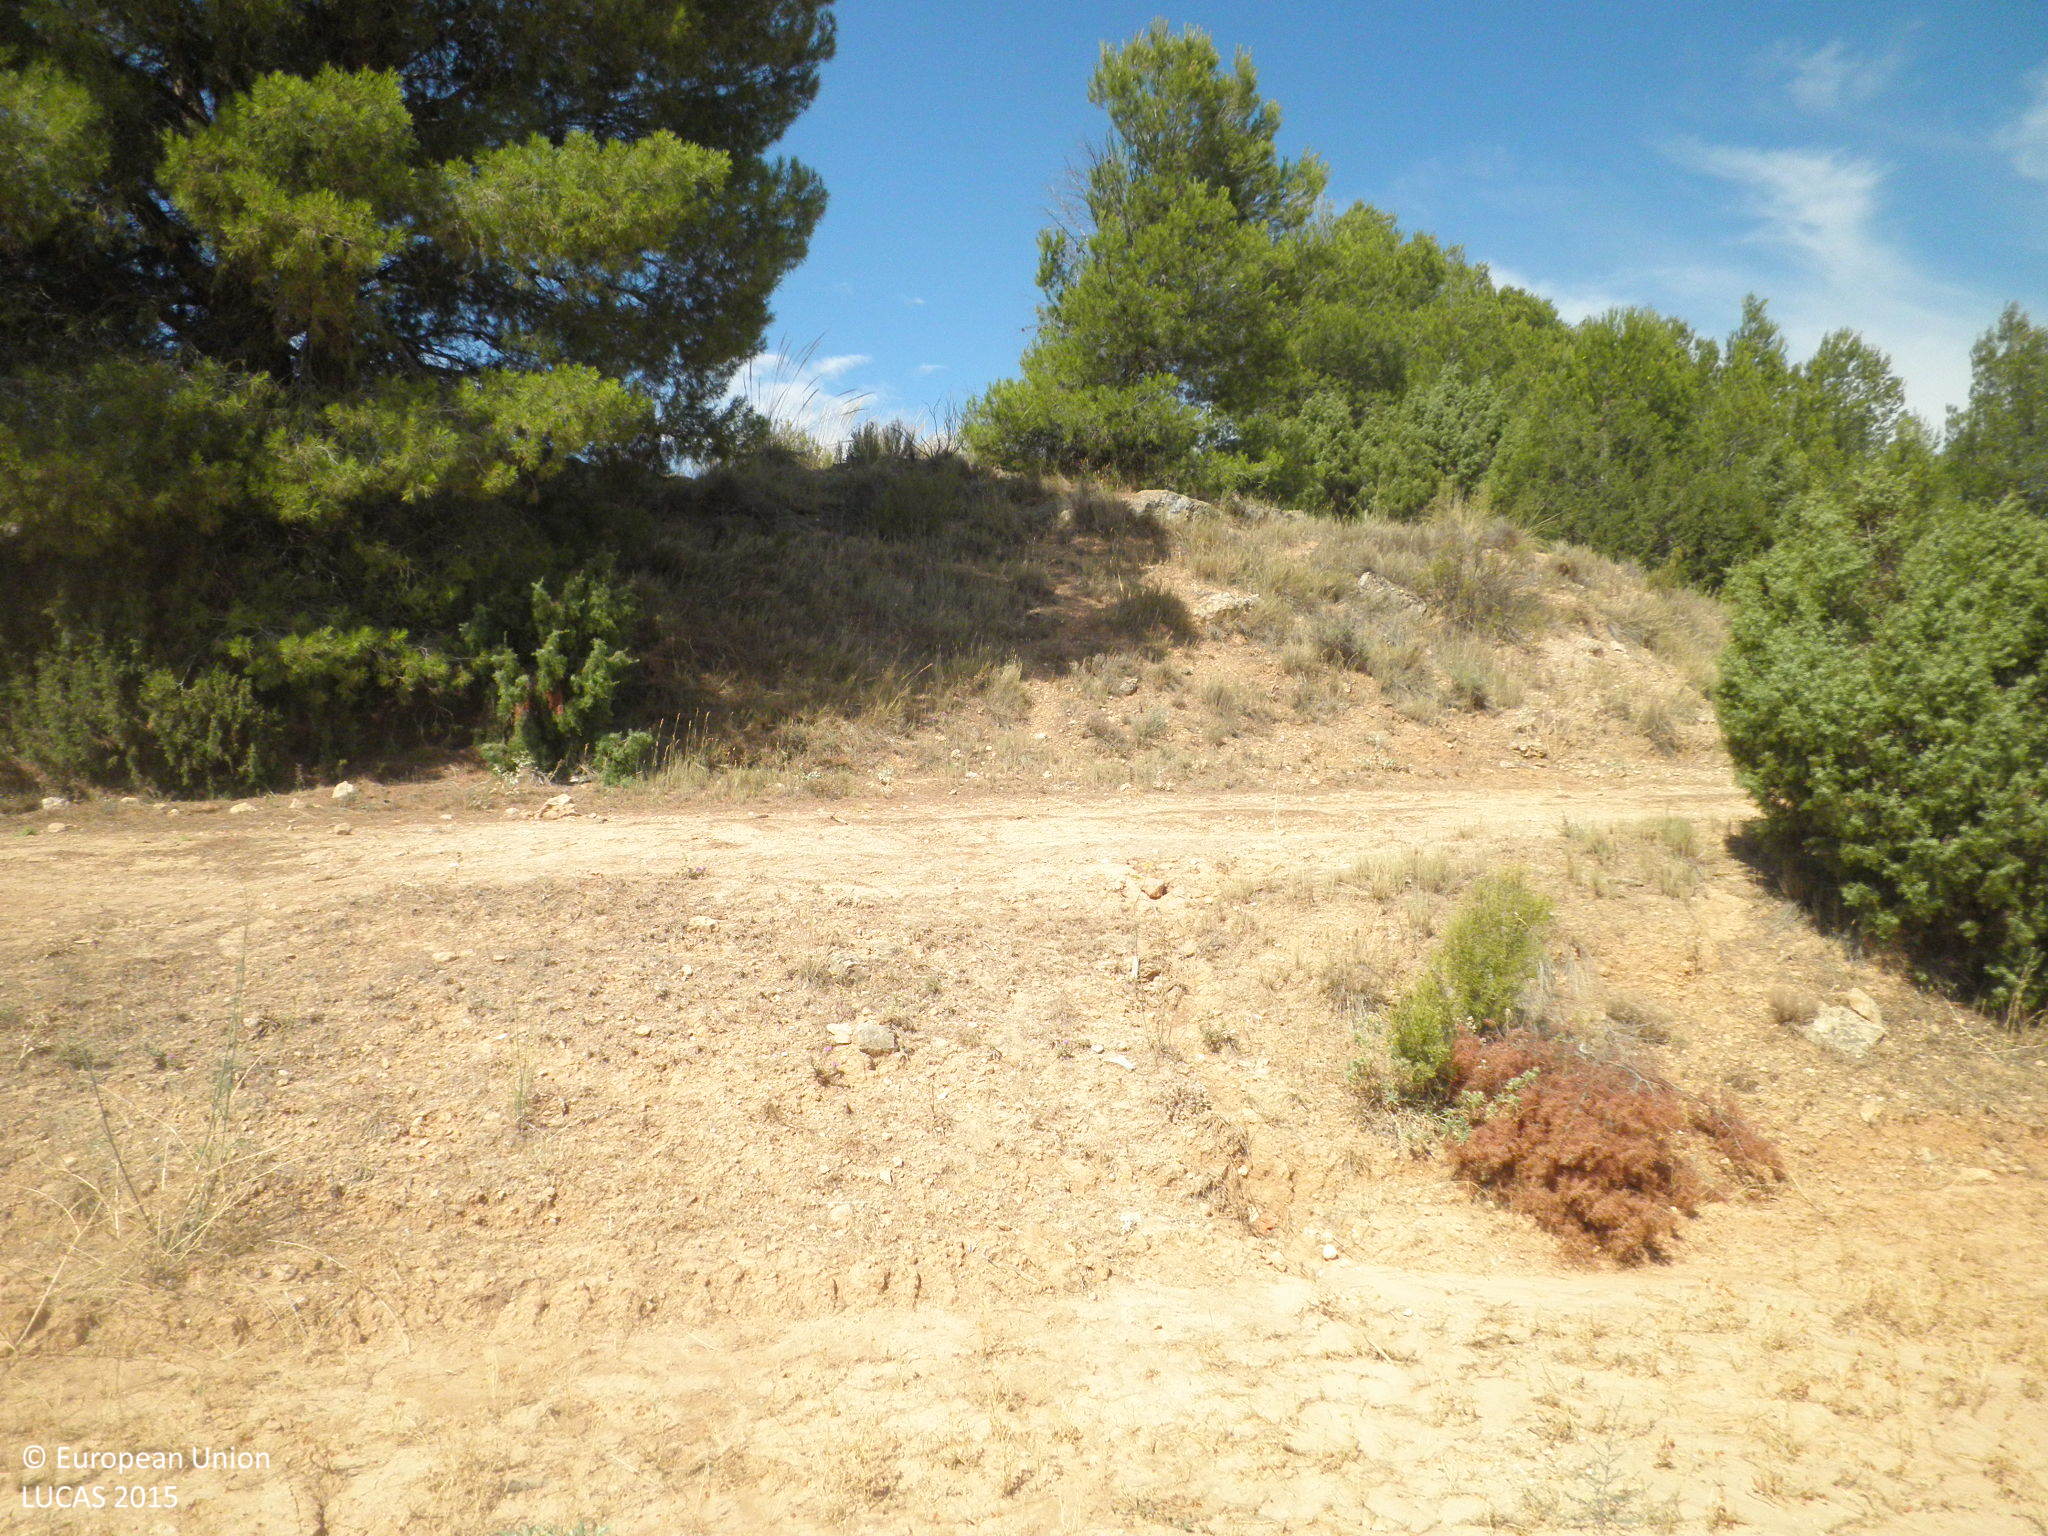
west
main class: Grassland
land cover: Spontaneously vegetated surfaces
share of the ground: 10 - 25 %
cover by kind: unconsolidated bare surface 75 %, herbaceous plants 25 %
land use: Fallow land
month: July
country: ES
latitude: 39.4735
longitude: -1.5472
